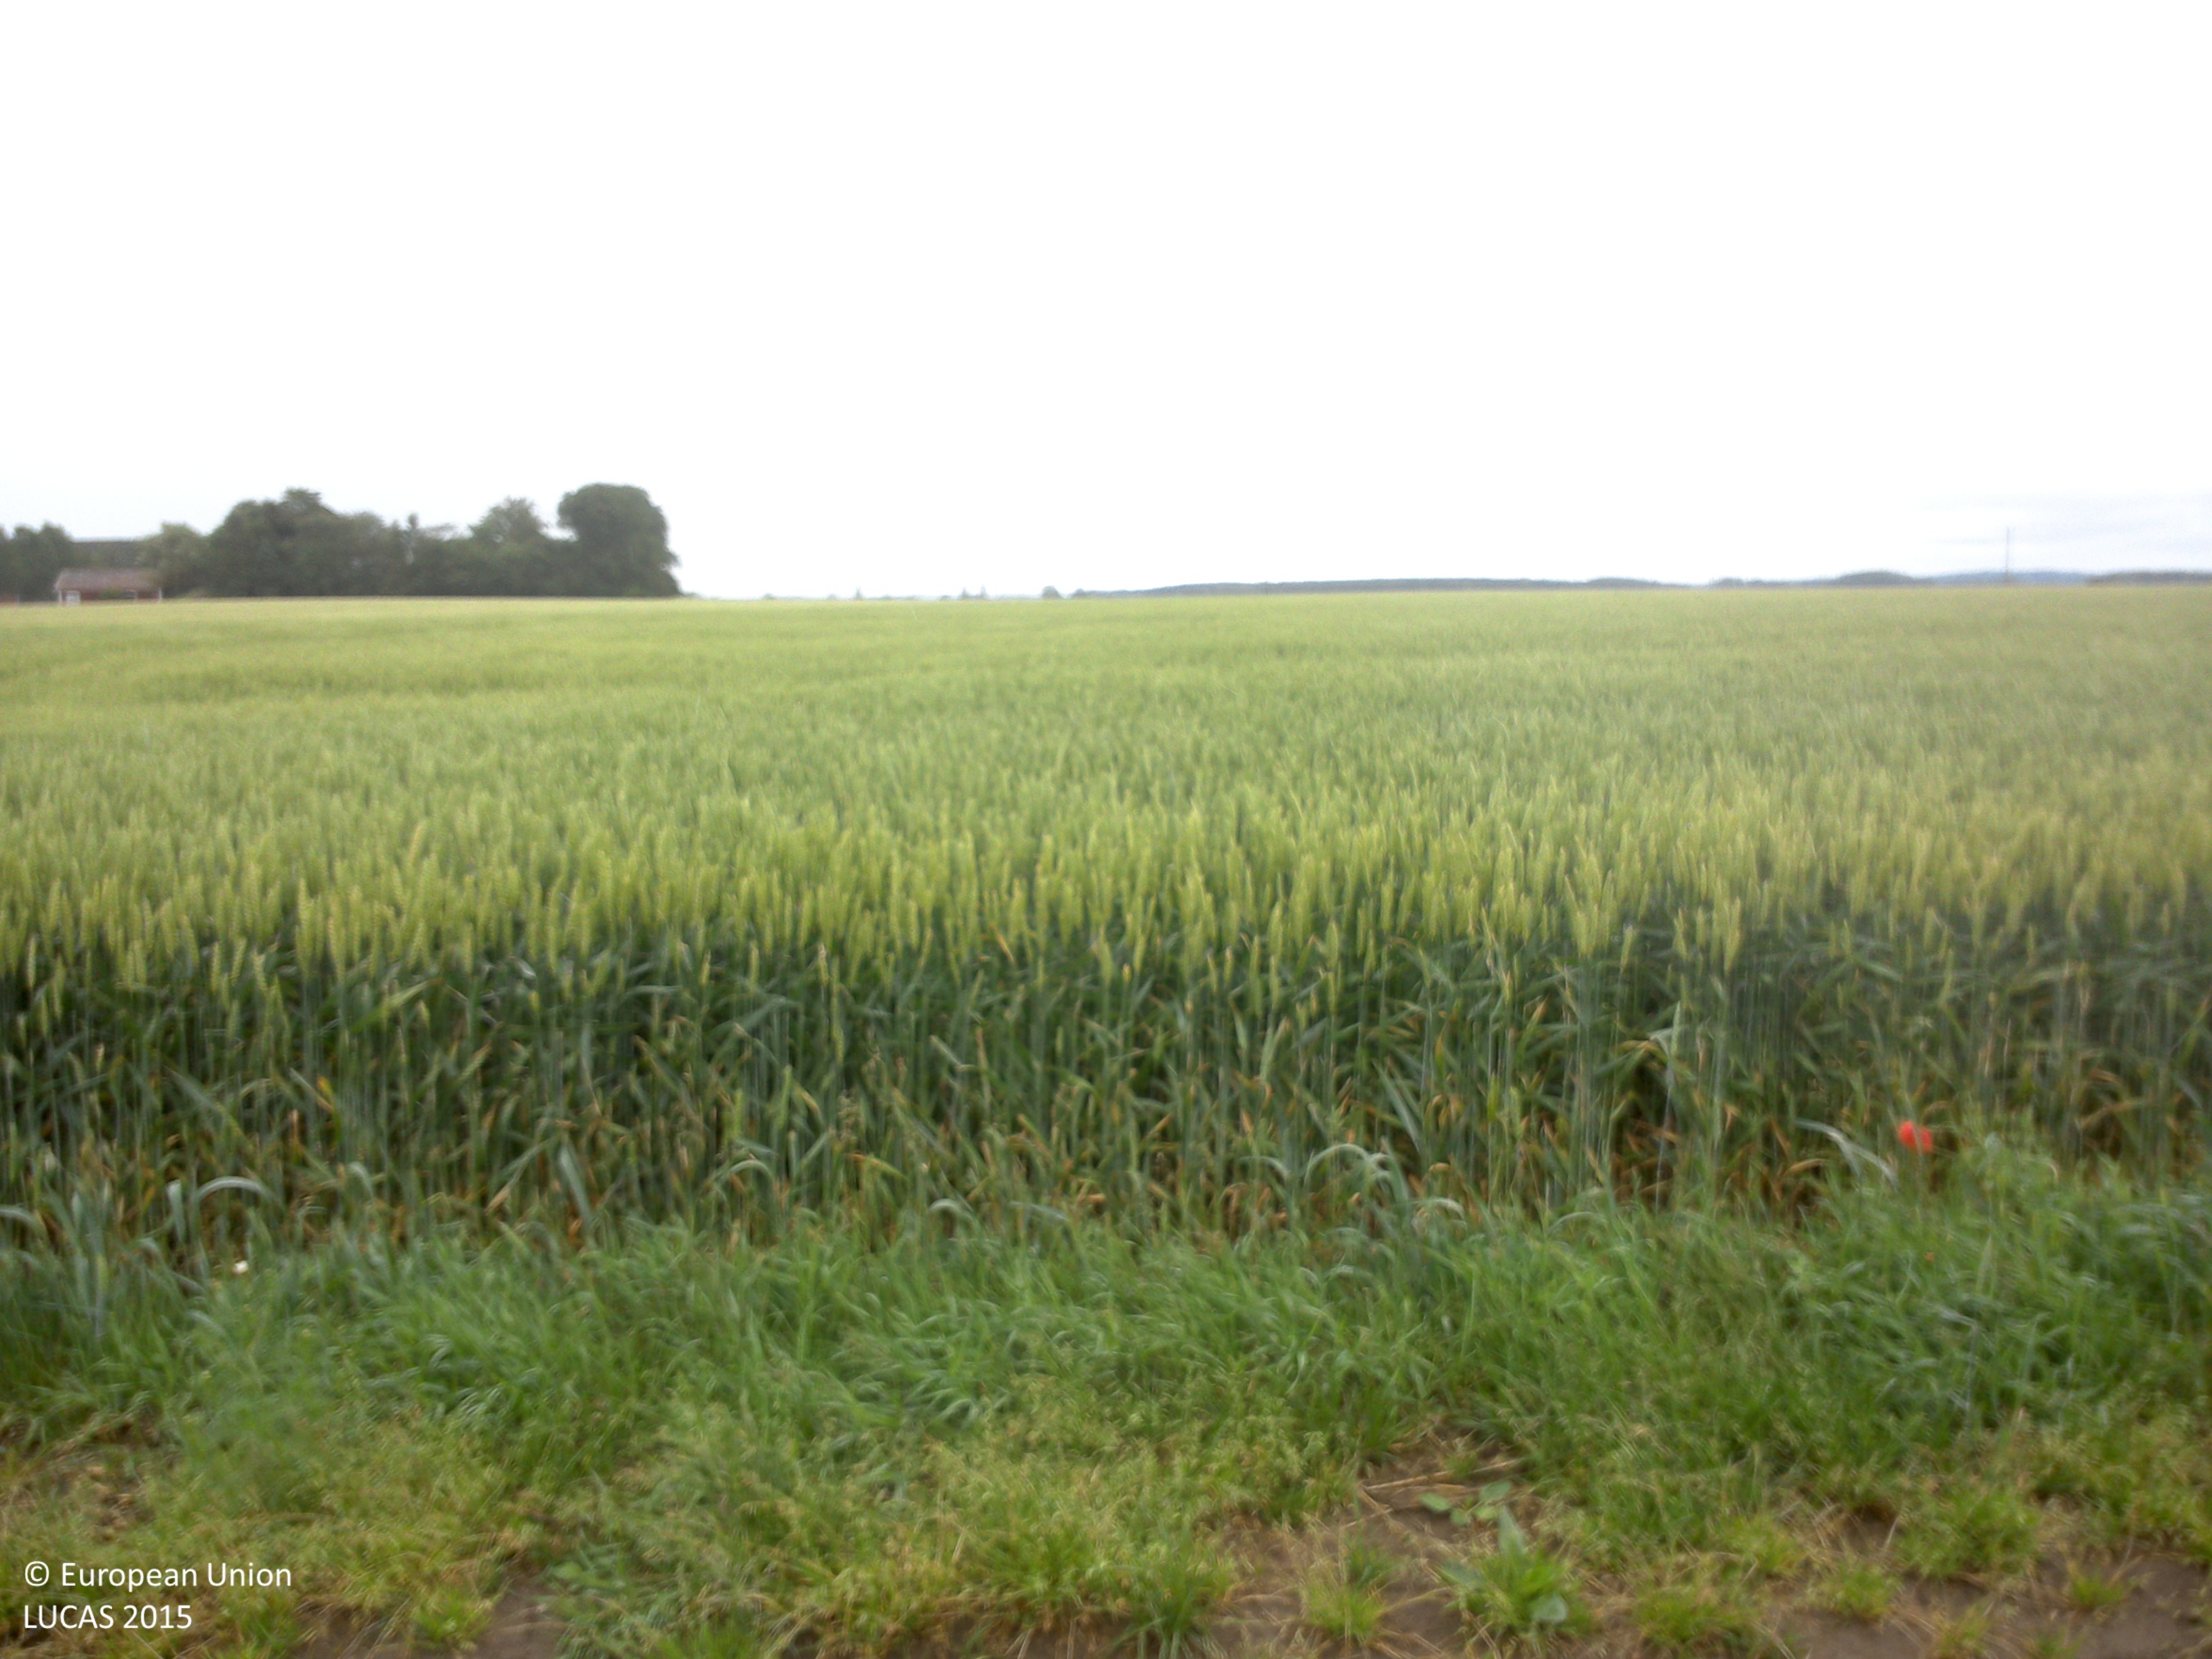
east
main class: Cropland
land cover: Common wheat
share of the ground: > 75 %
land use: Agriculture (excluding fallow land and kitchen gardens)
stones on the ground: < 10 %
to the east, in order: Common wheat; Tracks; Common wheat
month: July
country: SE
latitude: 58.3621
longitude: 14.9679
